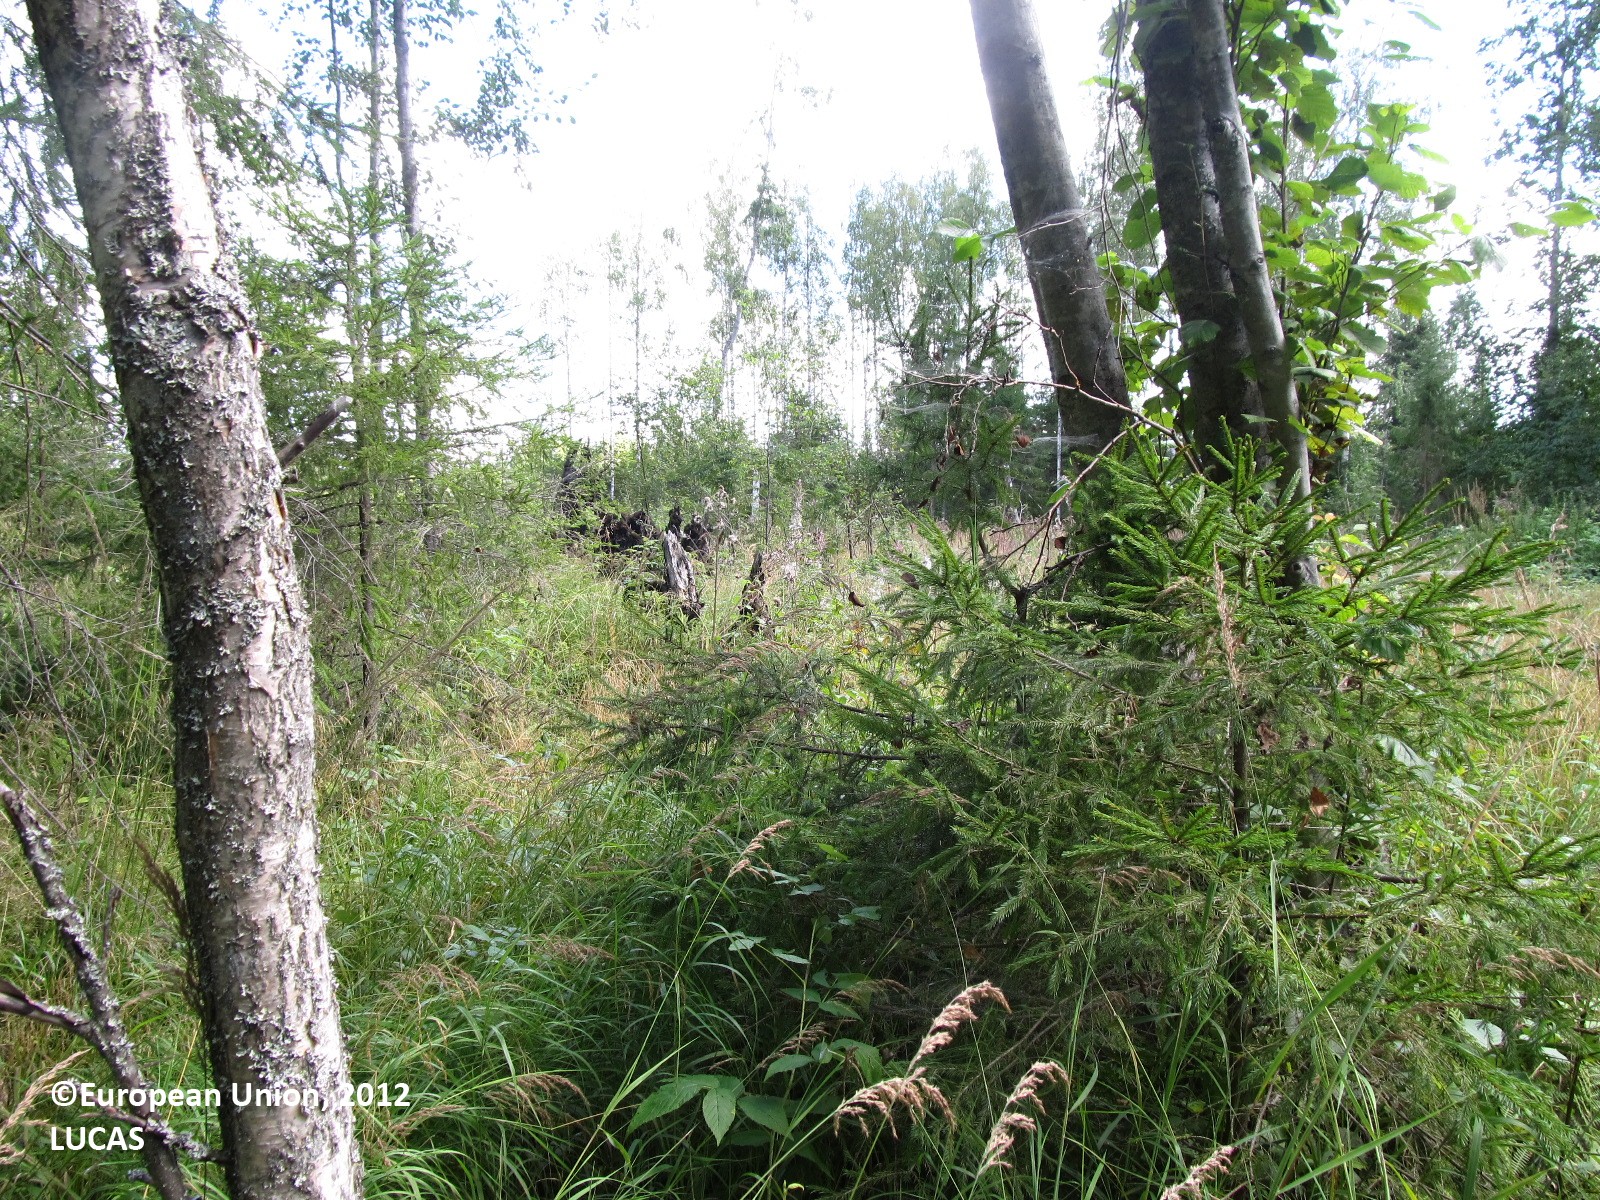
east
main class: Woodland
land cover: Spruce dominated mixed woodland
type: boreal forest
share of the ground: 25 - 50 %
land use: Forestry
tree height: > 5 m
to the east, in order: Spruce dominated mixed woodland; Shrubland without tree cover; Spruce dominated mixed woodland; Ditches and canals; Spruce dominated mixed woodland
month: August
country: FI
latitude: 62.2367
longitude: 27.5482
